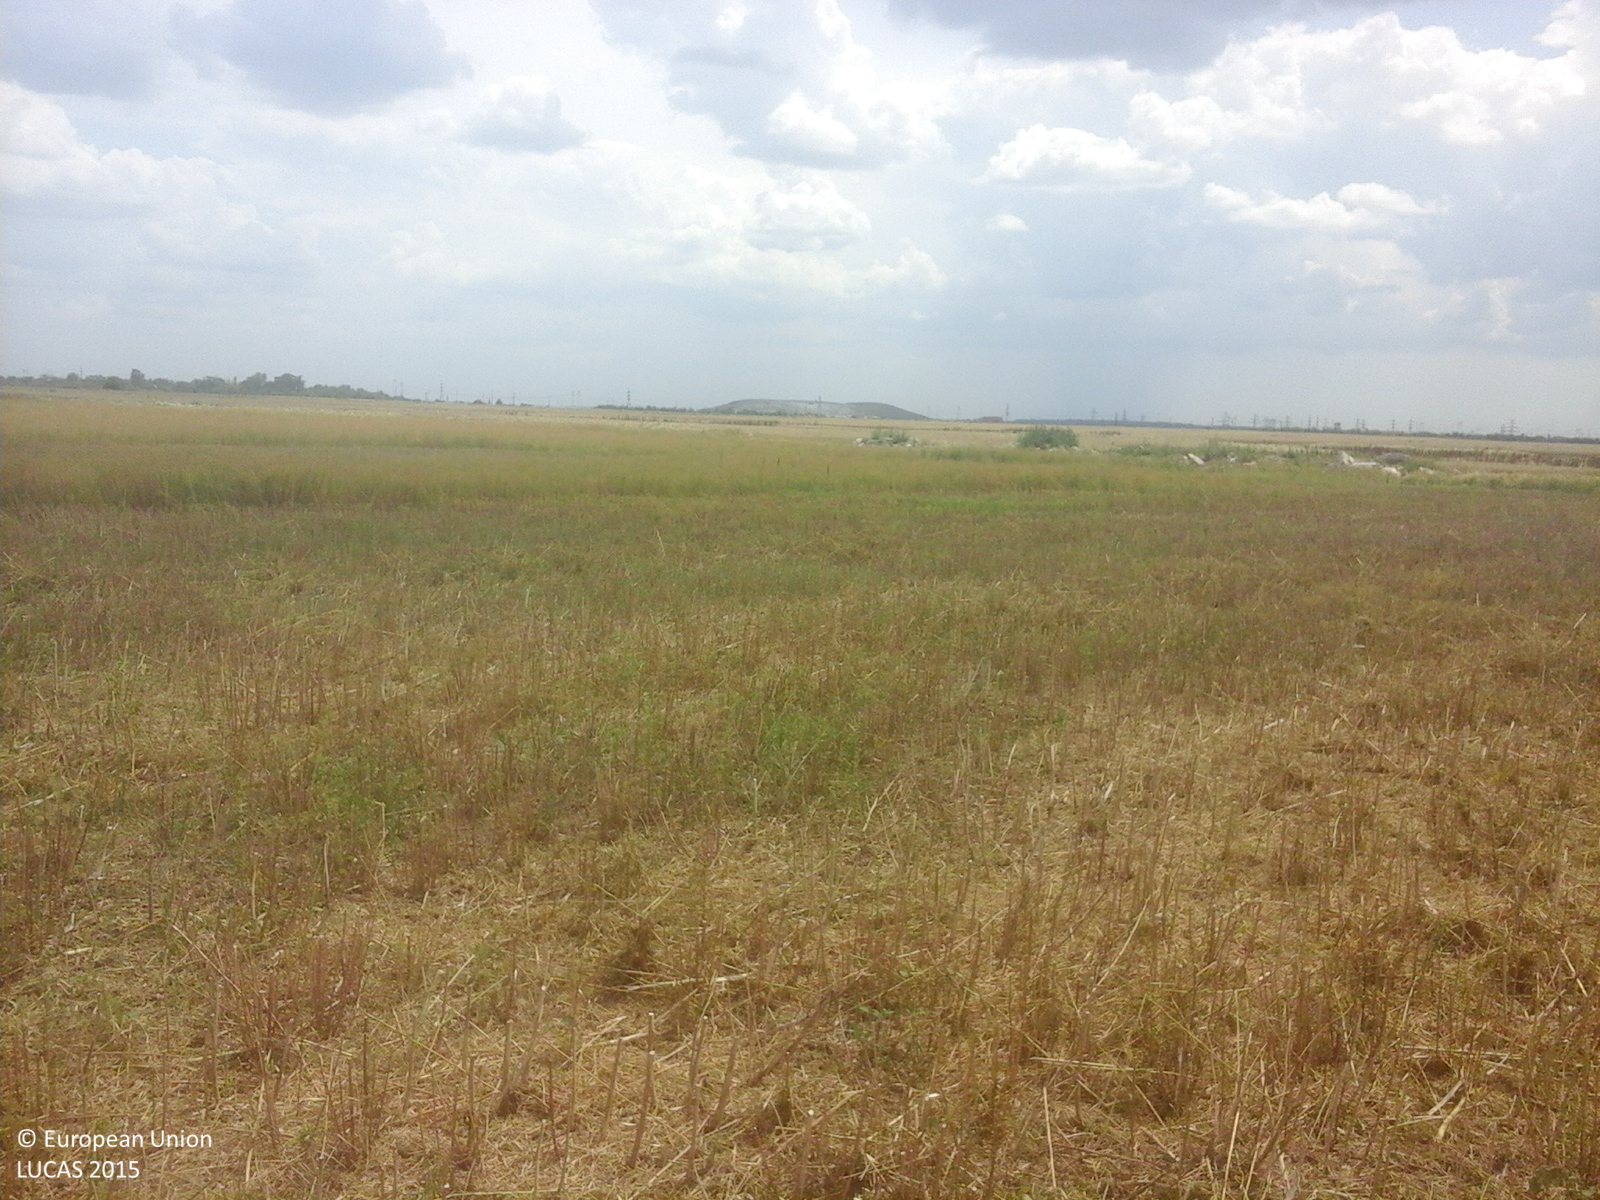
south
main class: Cropland
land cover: Other leguminous and mixtures for fodder
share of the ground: > 75 %
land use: Agriculture (excluding fallow land and kitchen gardens)
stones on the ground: < 10 %
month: June
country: RO
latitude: 44.3467
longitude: 26.1236
